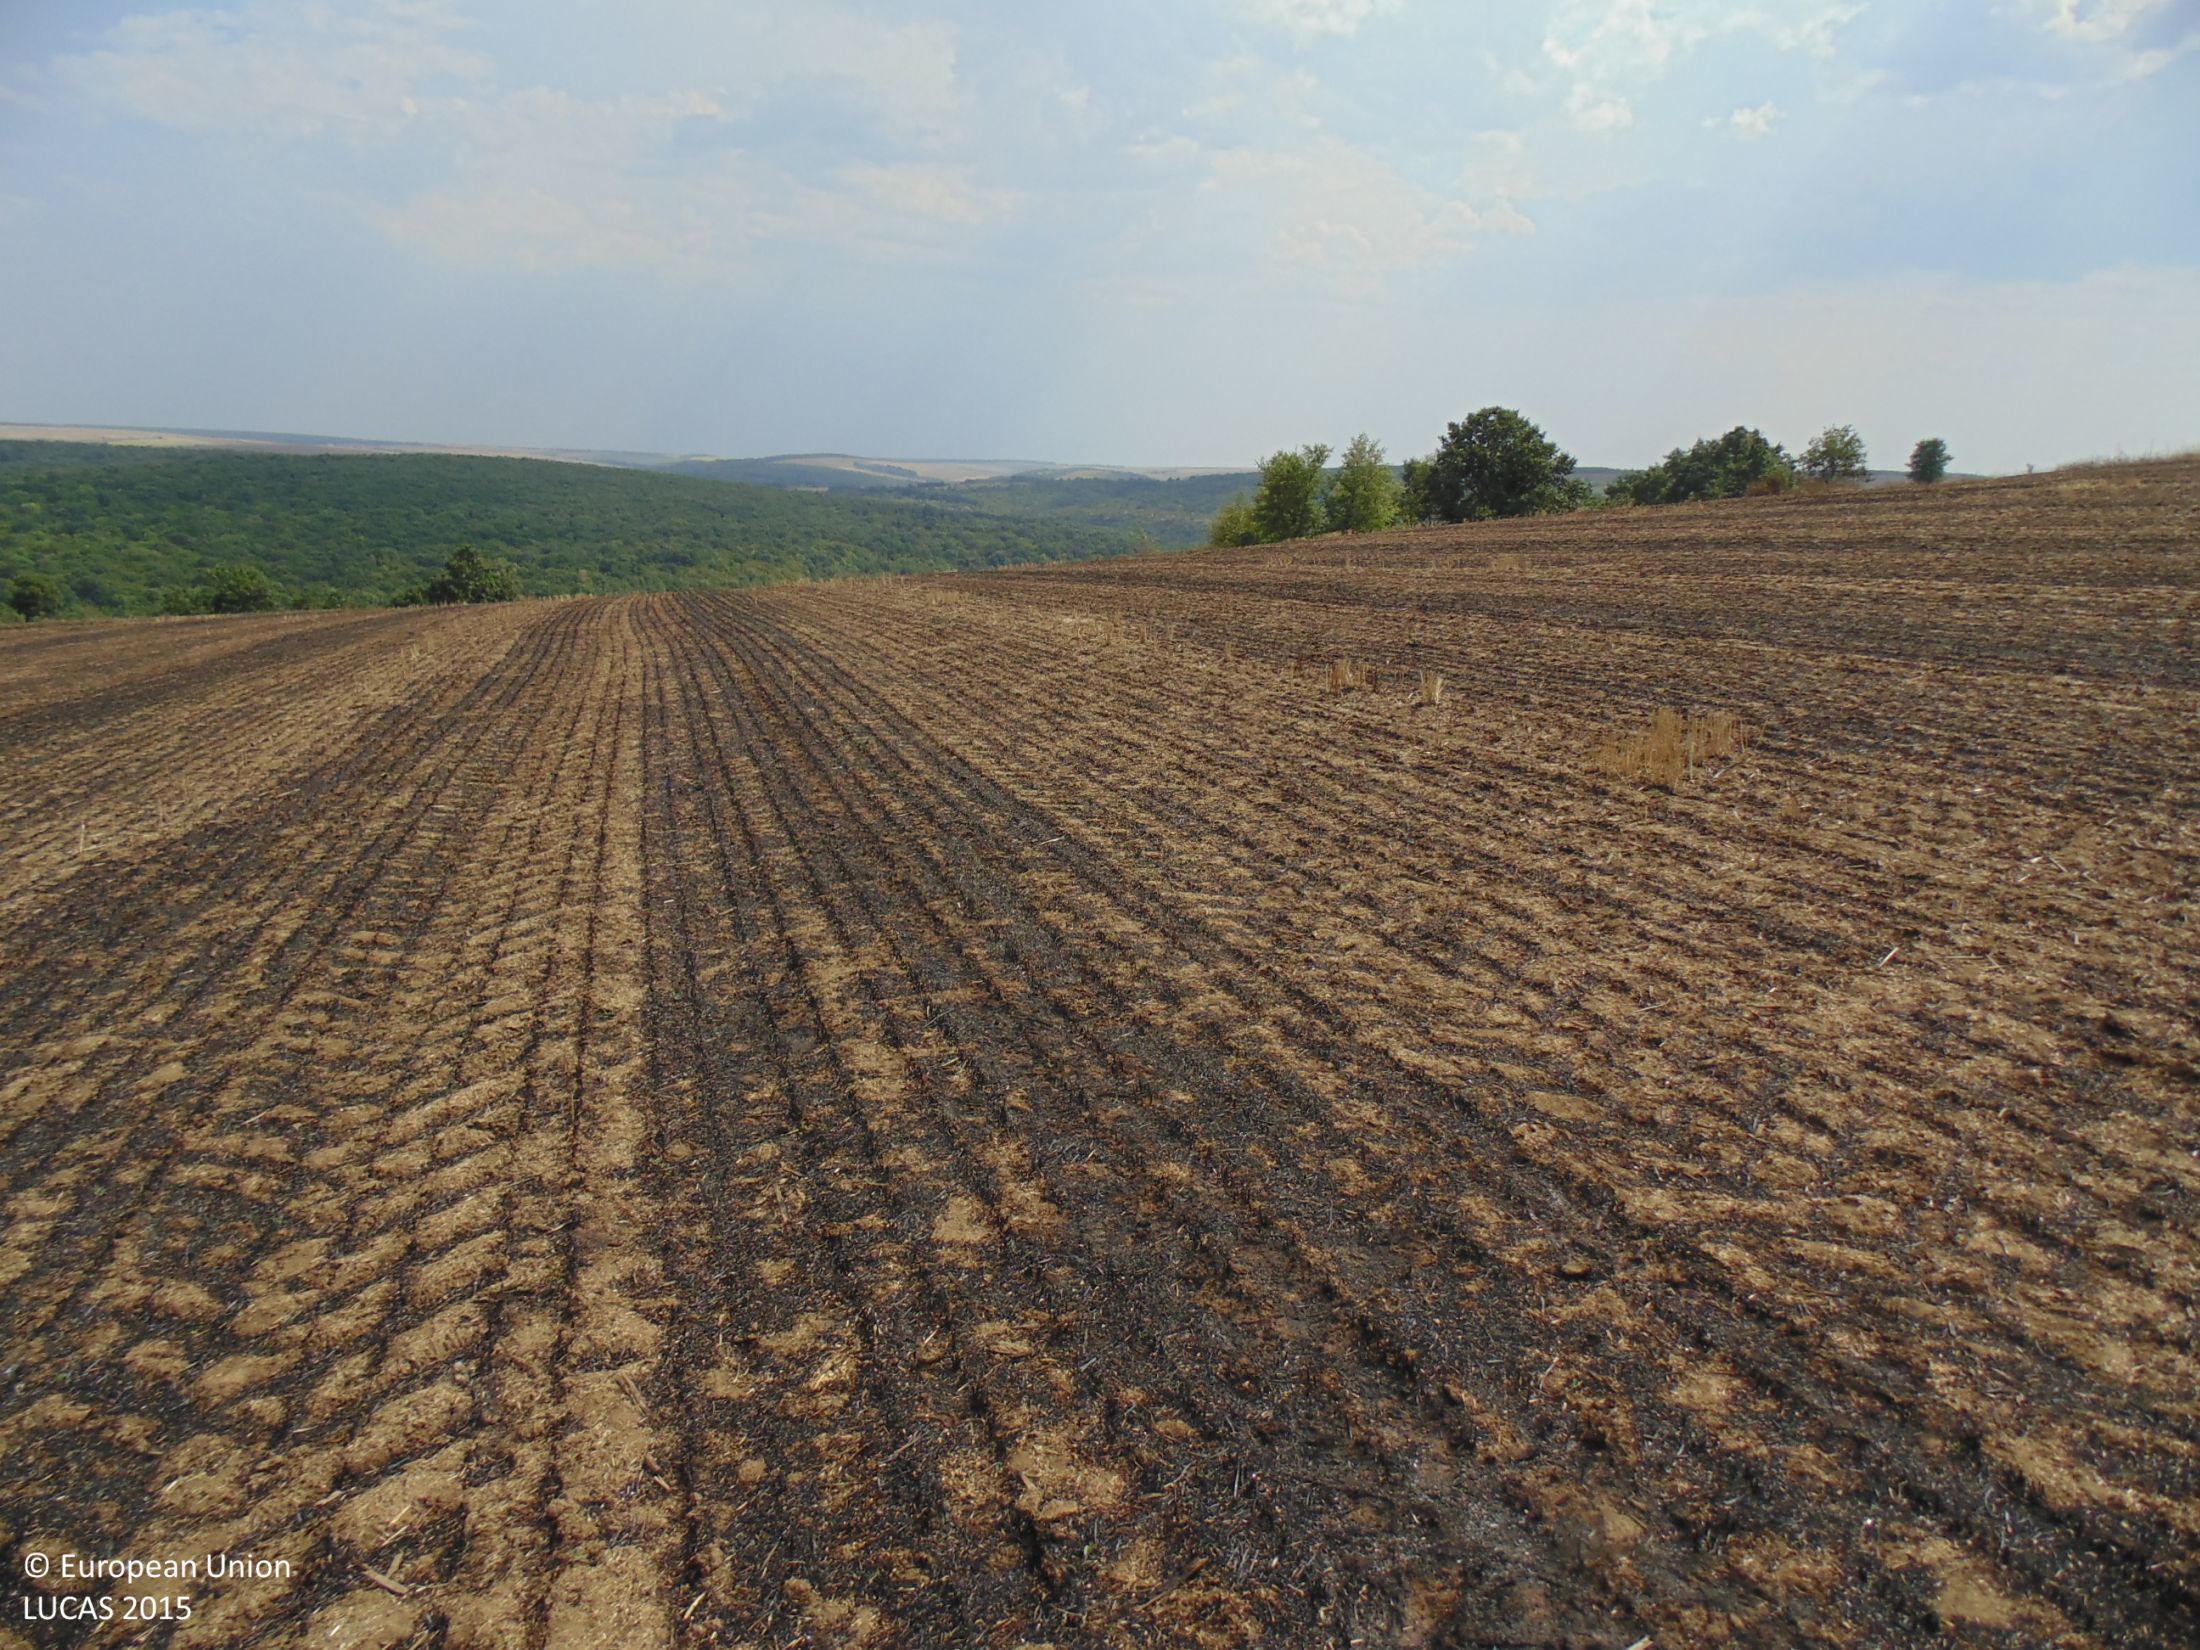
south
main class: Cropland
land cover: Common wheat
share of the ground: < 10 %
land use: Agriculture (excluding fallow land and kitchen gardens)
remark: Burnt area
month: August
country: BG
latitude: 43.9344
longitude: 27.6171
